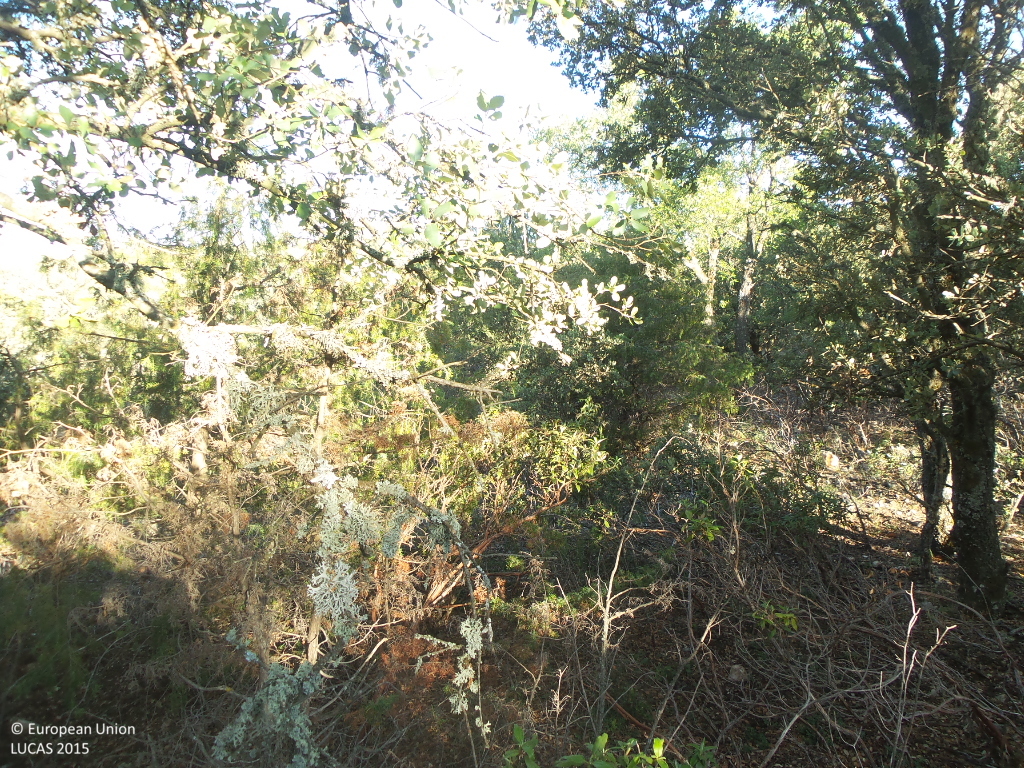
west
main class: Woodland
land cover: Broadleaved woodland
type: broadleaved evergreen forest
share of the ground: > 75 %
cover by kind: broadleaved forest trees 80 %, shrubs 10 %, herbaceous plants 5 %, unconsolidated bare surface 5 %
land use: Semi-natural and natural areas not in use
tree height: > 5 m
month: June
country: ES
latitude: 41.0373
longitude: -2.9177
